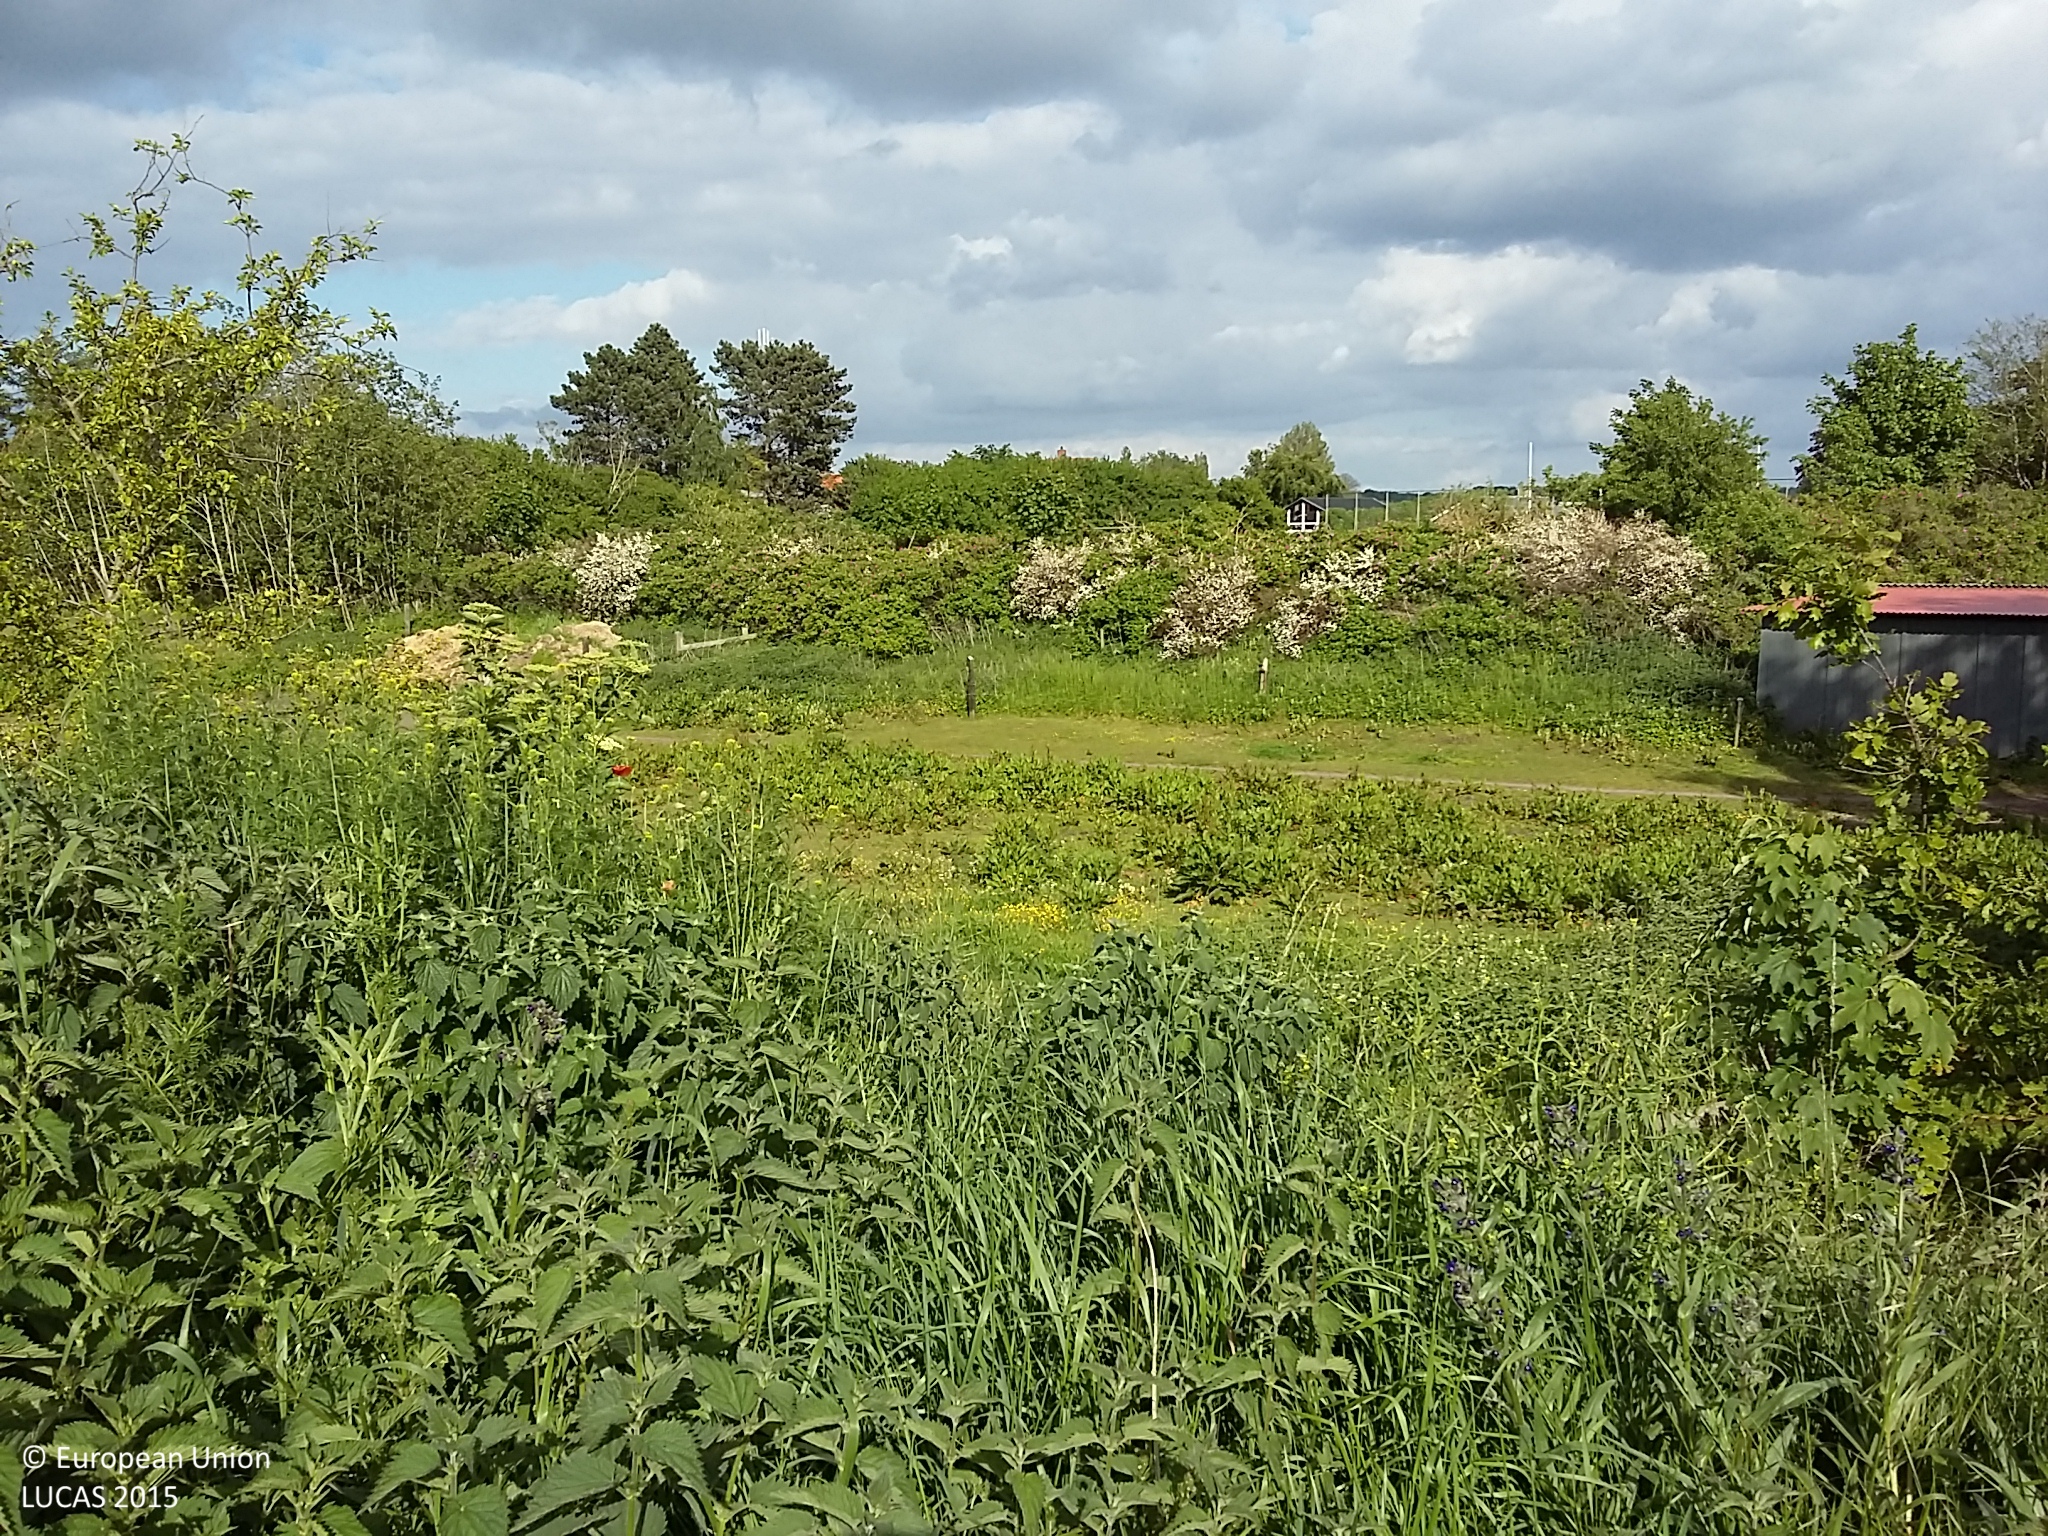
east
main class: Woodland
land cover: Broadleaved woodland
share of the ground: > 75 %
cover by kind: herbaceous plants 60 %, broadleaved forest trees 40 %
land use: Agriculture (excluding fallow land and kitchen gardens)
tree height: > 5 m
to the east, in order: Broadleaved woodland; Grassland without tree/shrub cover; Broadleaved woodland; Artificial constructions in urban areas; Shruby margins
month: June
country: DK
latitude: 55.3408
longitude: 10.7404
